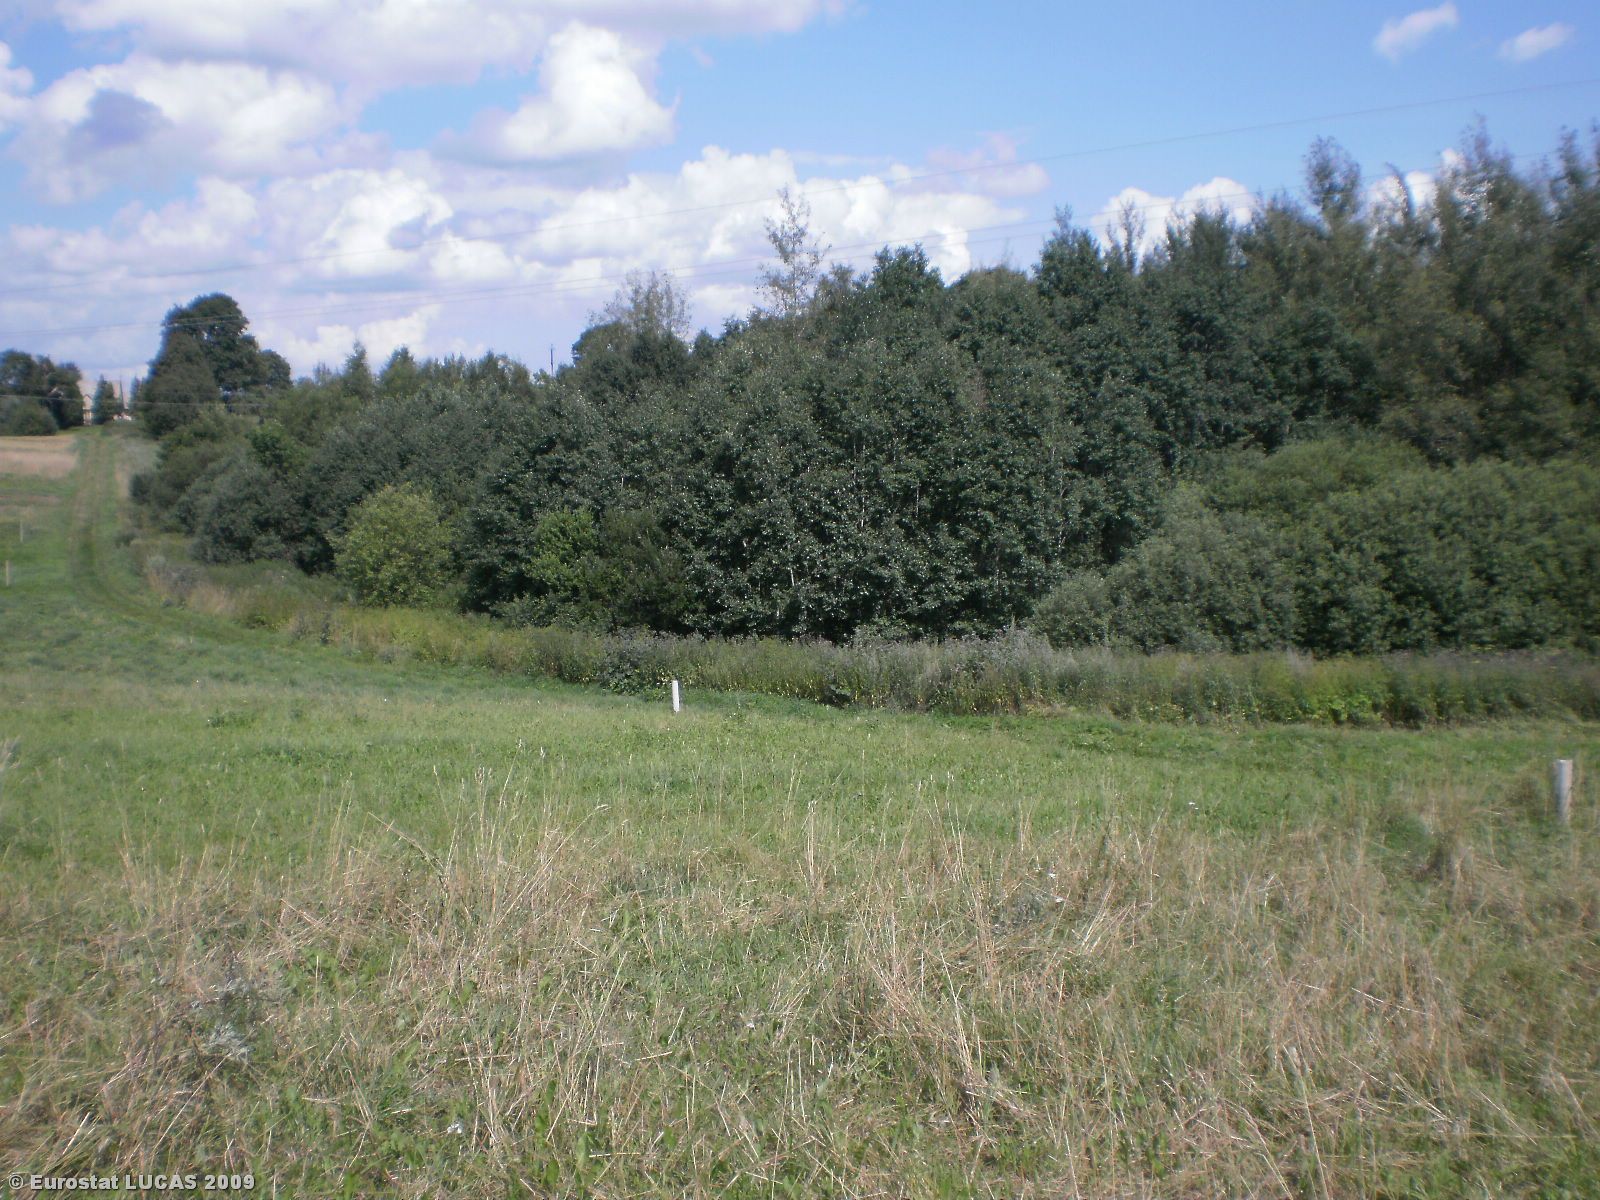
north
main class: Grassland
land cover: Grassland without tree/shrub cover
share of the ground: > 75 %
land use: Agriculture (excluding fallow land and kitchen gardens)
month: July
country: LT
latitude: 55.9632
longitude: 25.7152
